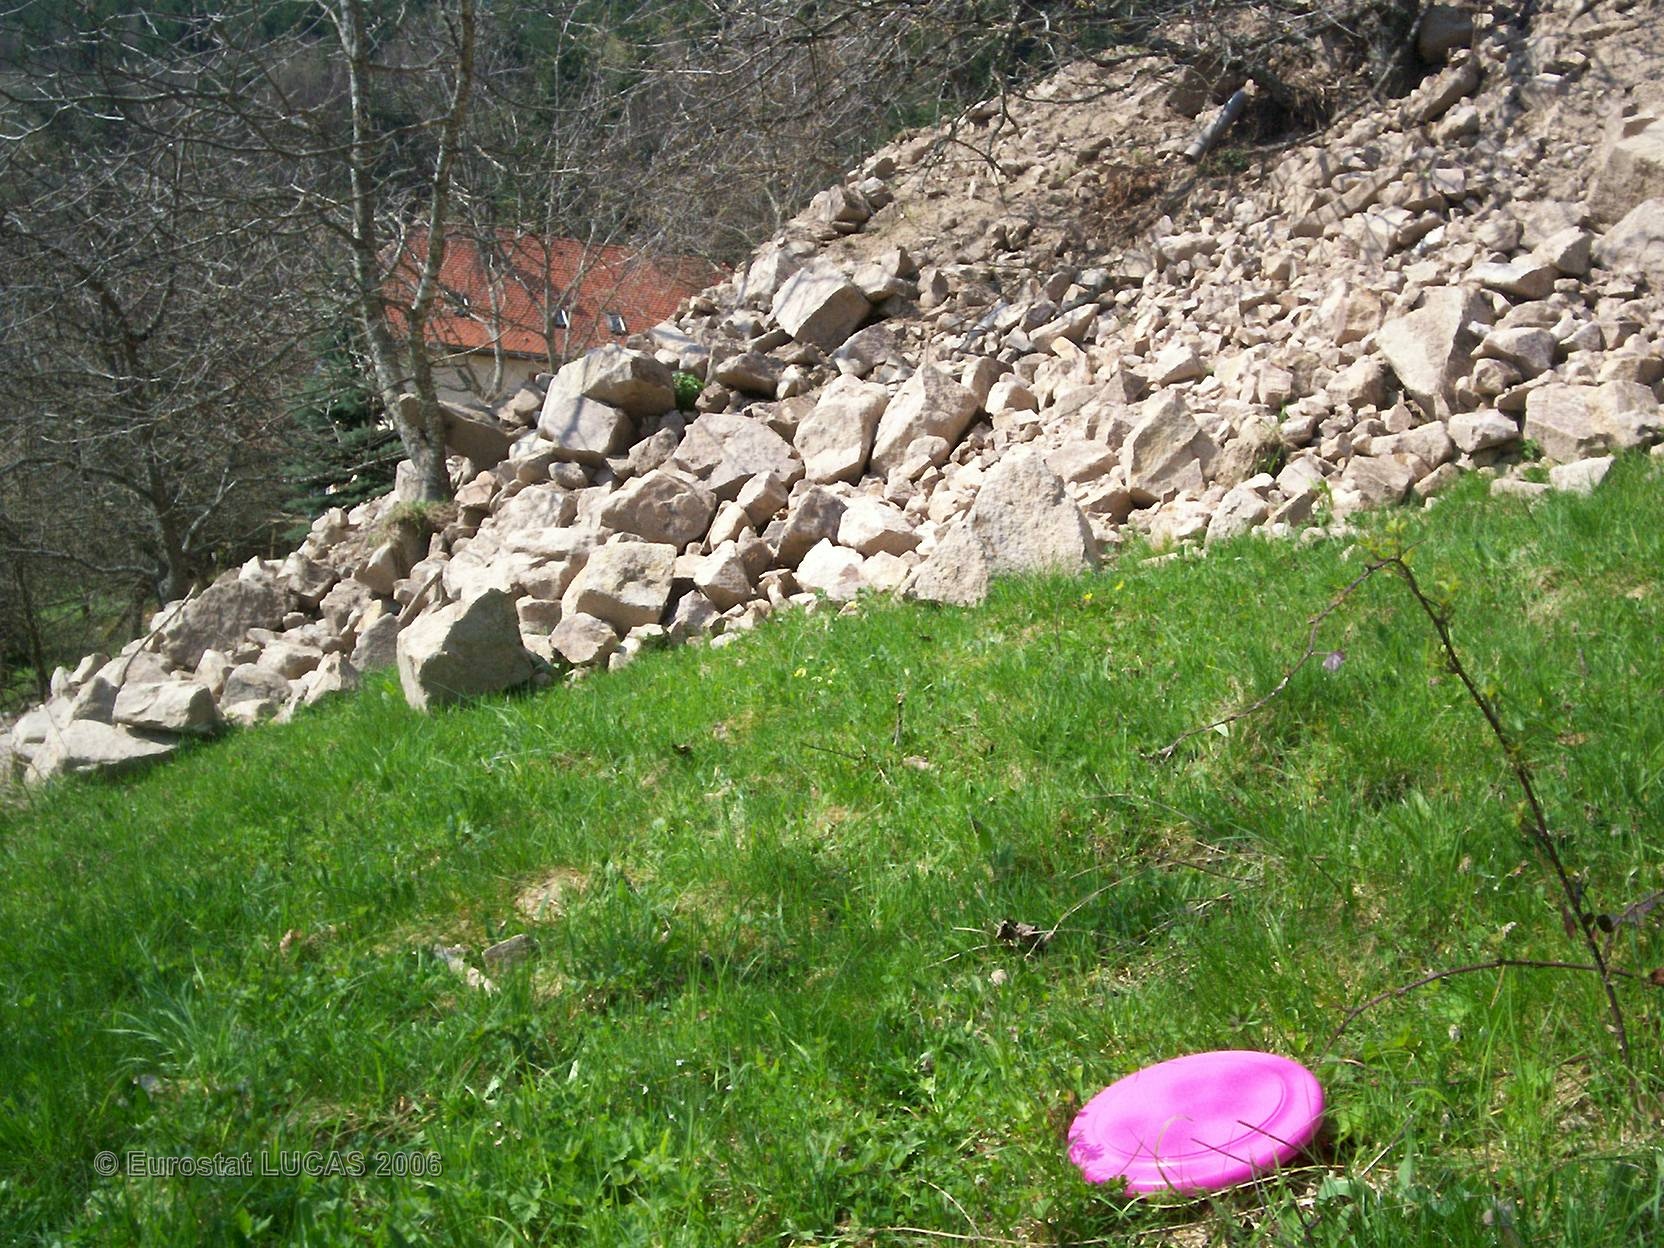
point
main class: Cropland
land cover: Other fruit trees and berries
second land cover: Grassland with sparse tree/shrub cover
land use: Kitchen garden
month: April
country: FR
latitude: 48.0238
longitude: 7.1183
